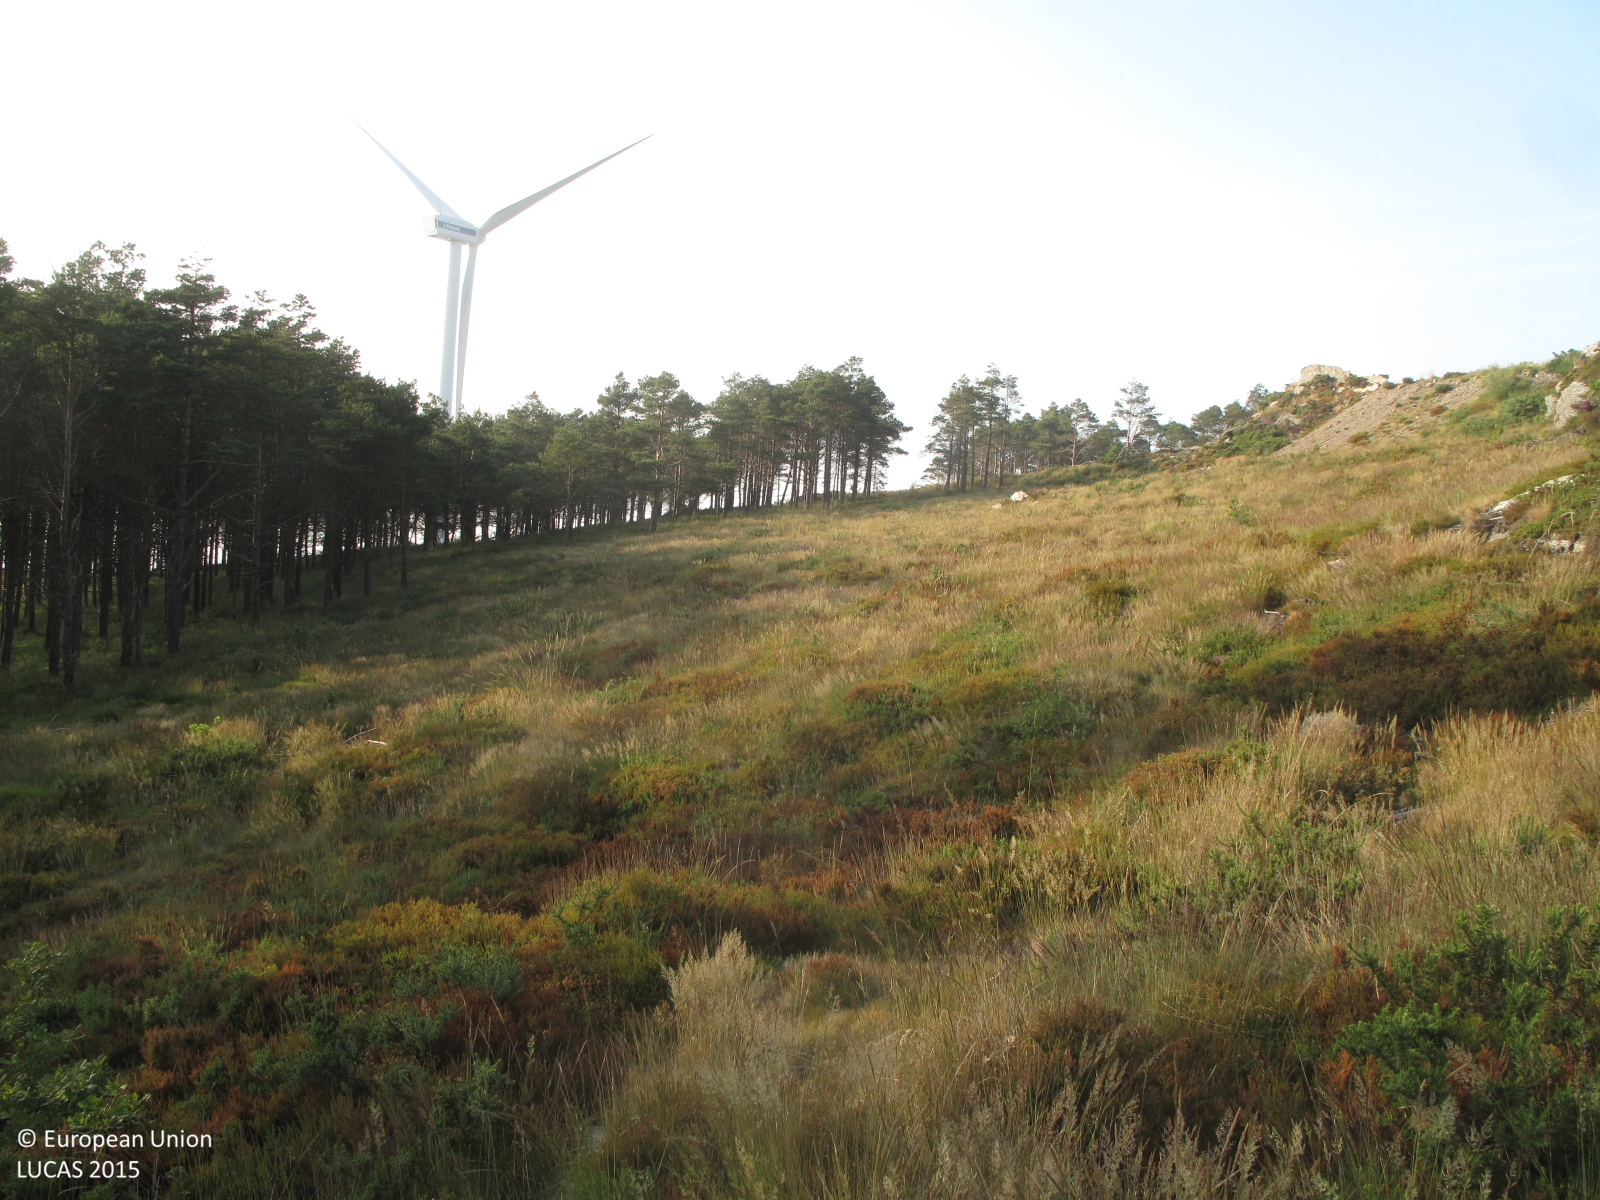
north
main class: Shrubland
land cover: Shrubland with sparse tree cover
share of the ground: 25 - 50 %
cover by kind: herbaceous plants 50 %, shrubs 45 %, broadleaved forest trees 5 %
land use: Semi-natural and natural areas not in use
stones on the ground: 10 - 25 %
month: June
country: ES
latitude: 43.0896
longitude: -7.9134
